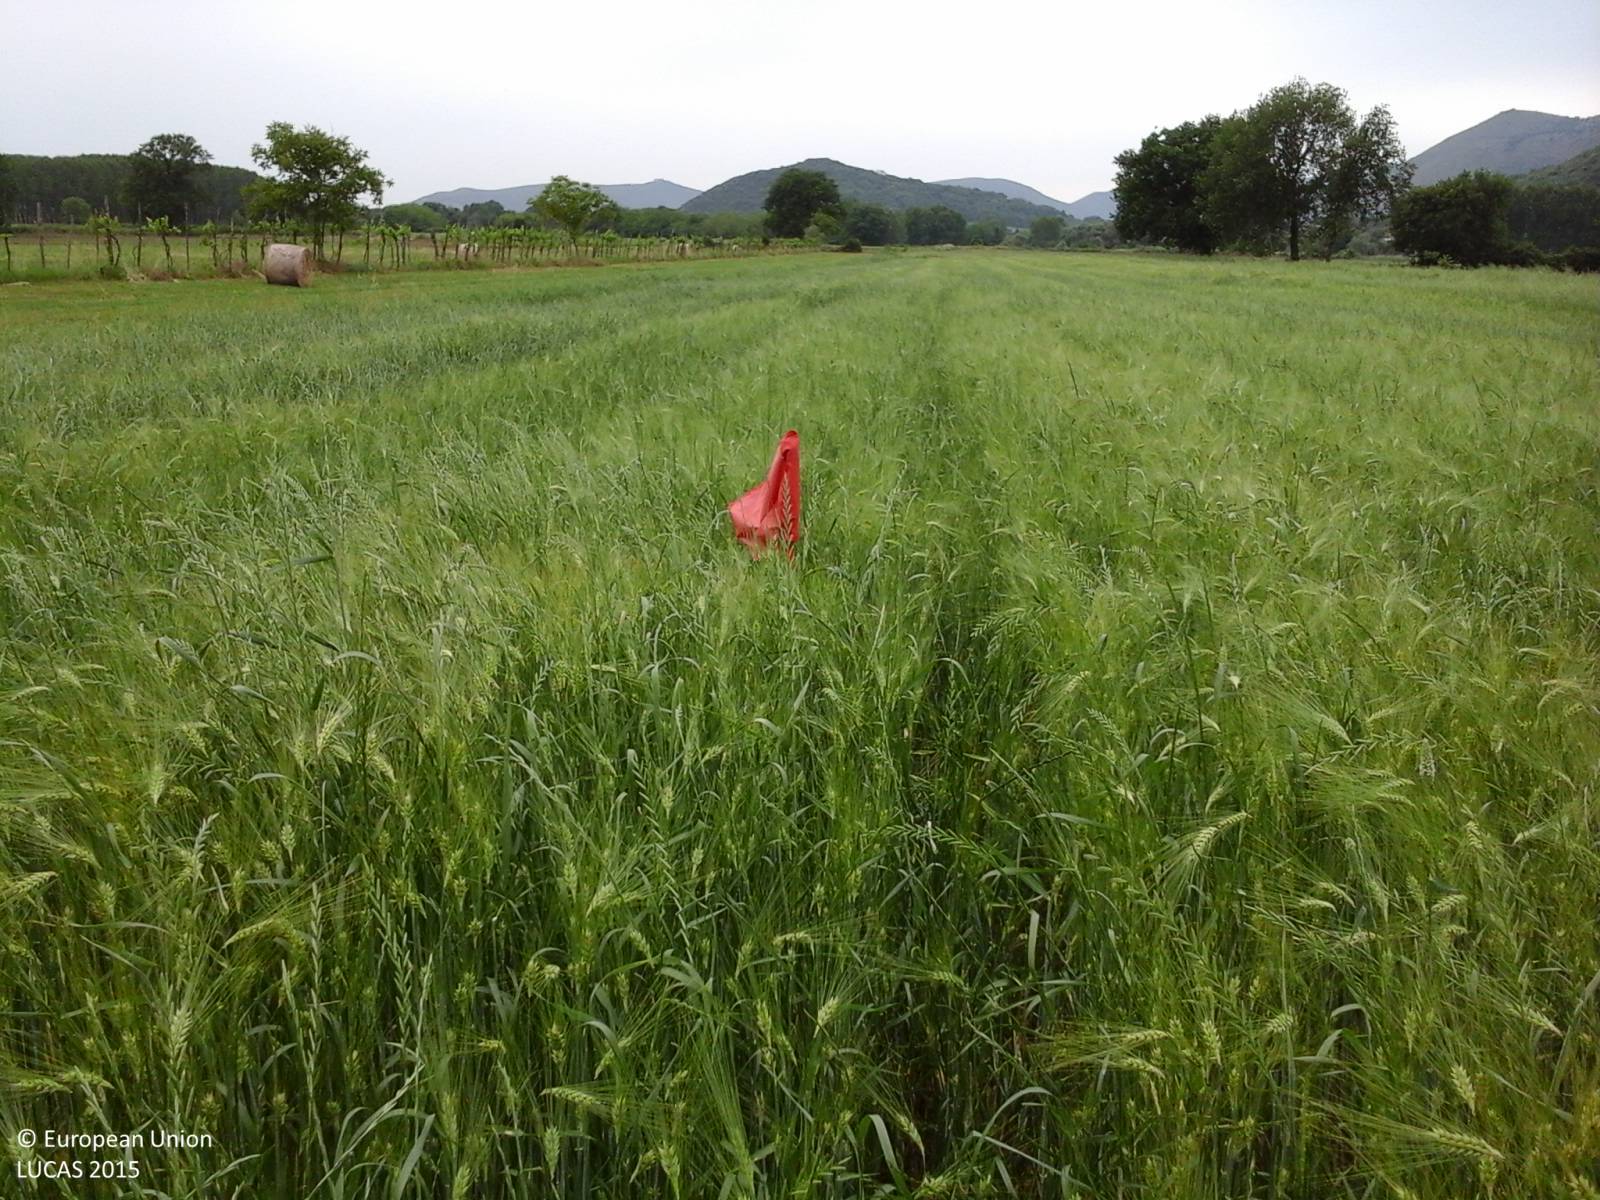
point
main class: Cropland
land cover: Barley
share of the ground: > 75 %
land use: Agriculture (excluding fallow land and kitchen gardens)
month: May
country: IT
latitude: 41.1489
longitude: 14.3559
